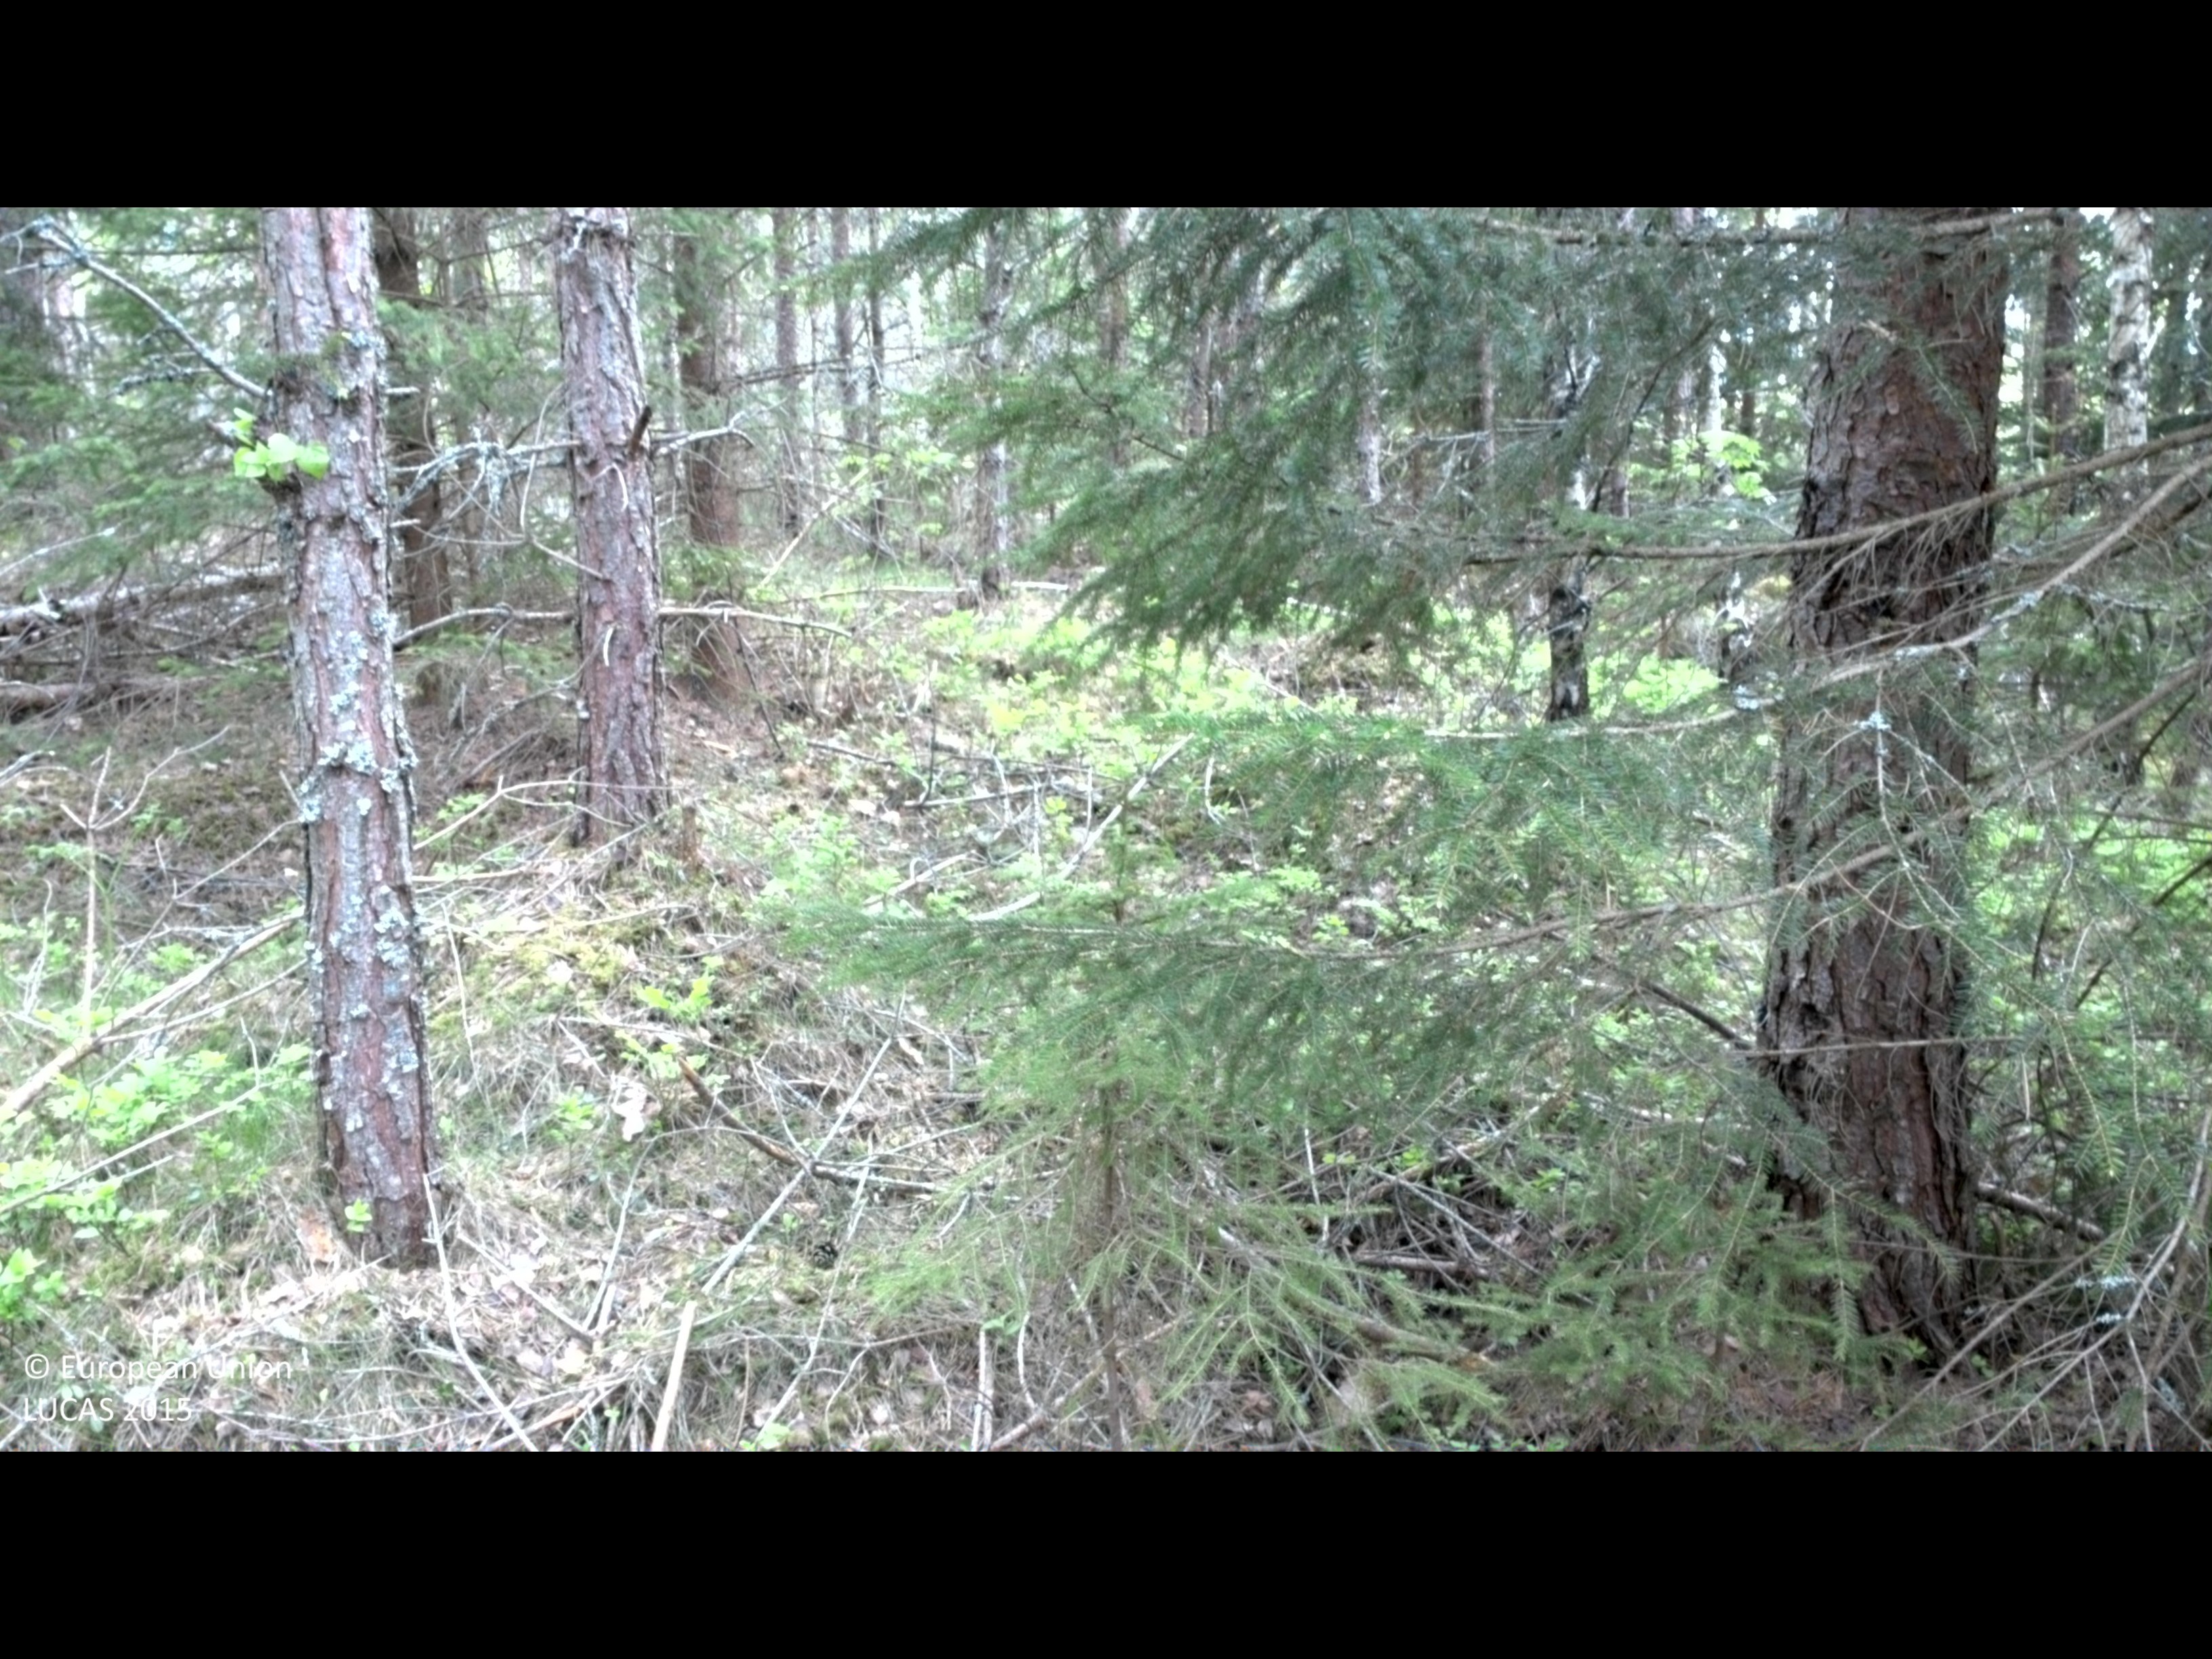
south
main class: Woodland
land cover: Pine dominated mixed woodland
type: boreal forest
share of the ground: > 75 %
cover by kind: coniferous forest trees 60 %, broadleaved forest trees 20 %, shrubs 10 %, lichens and mosses 10 %
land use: Forestry
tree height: > 5 m
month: May
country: SE
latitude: 57.3221
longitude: 16.1264
